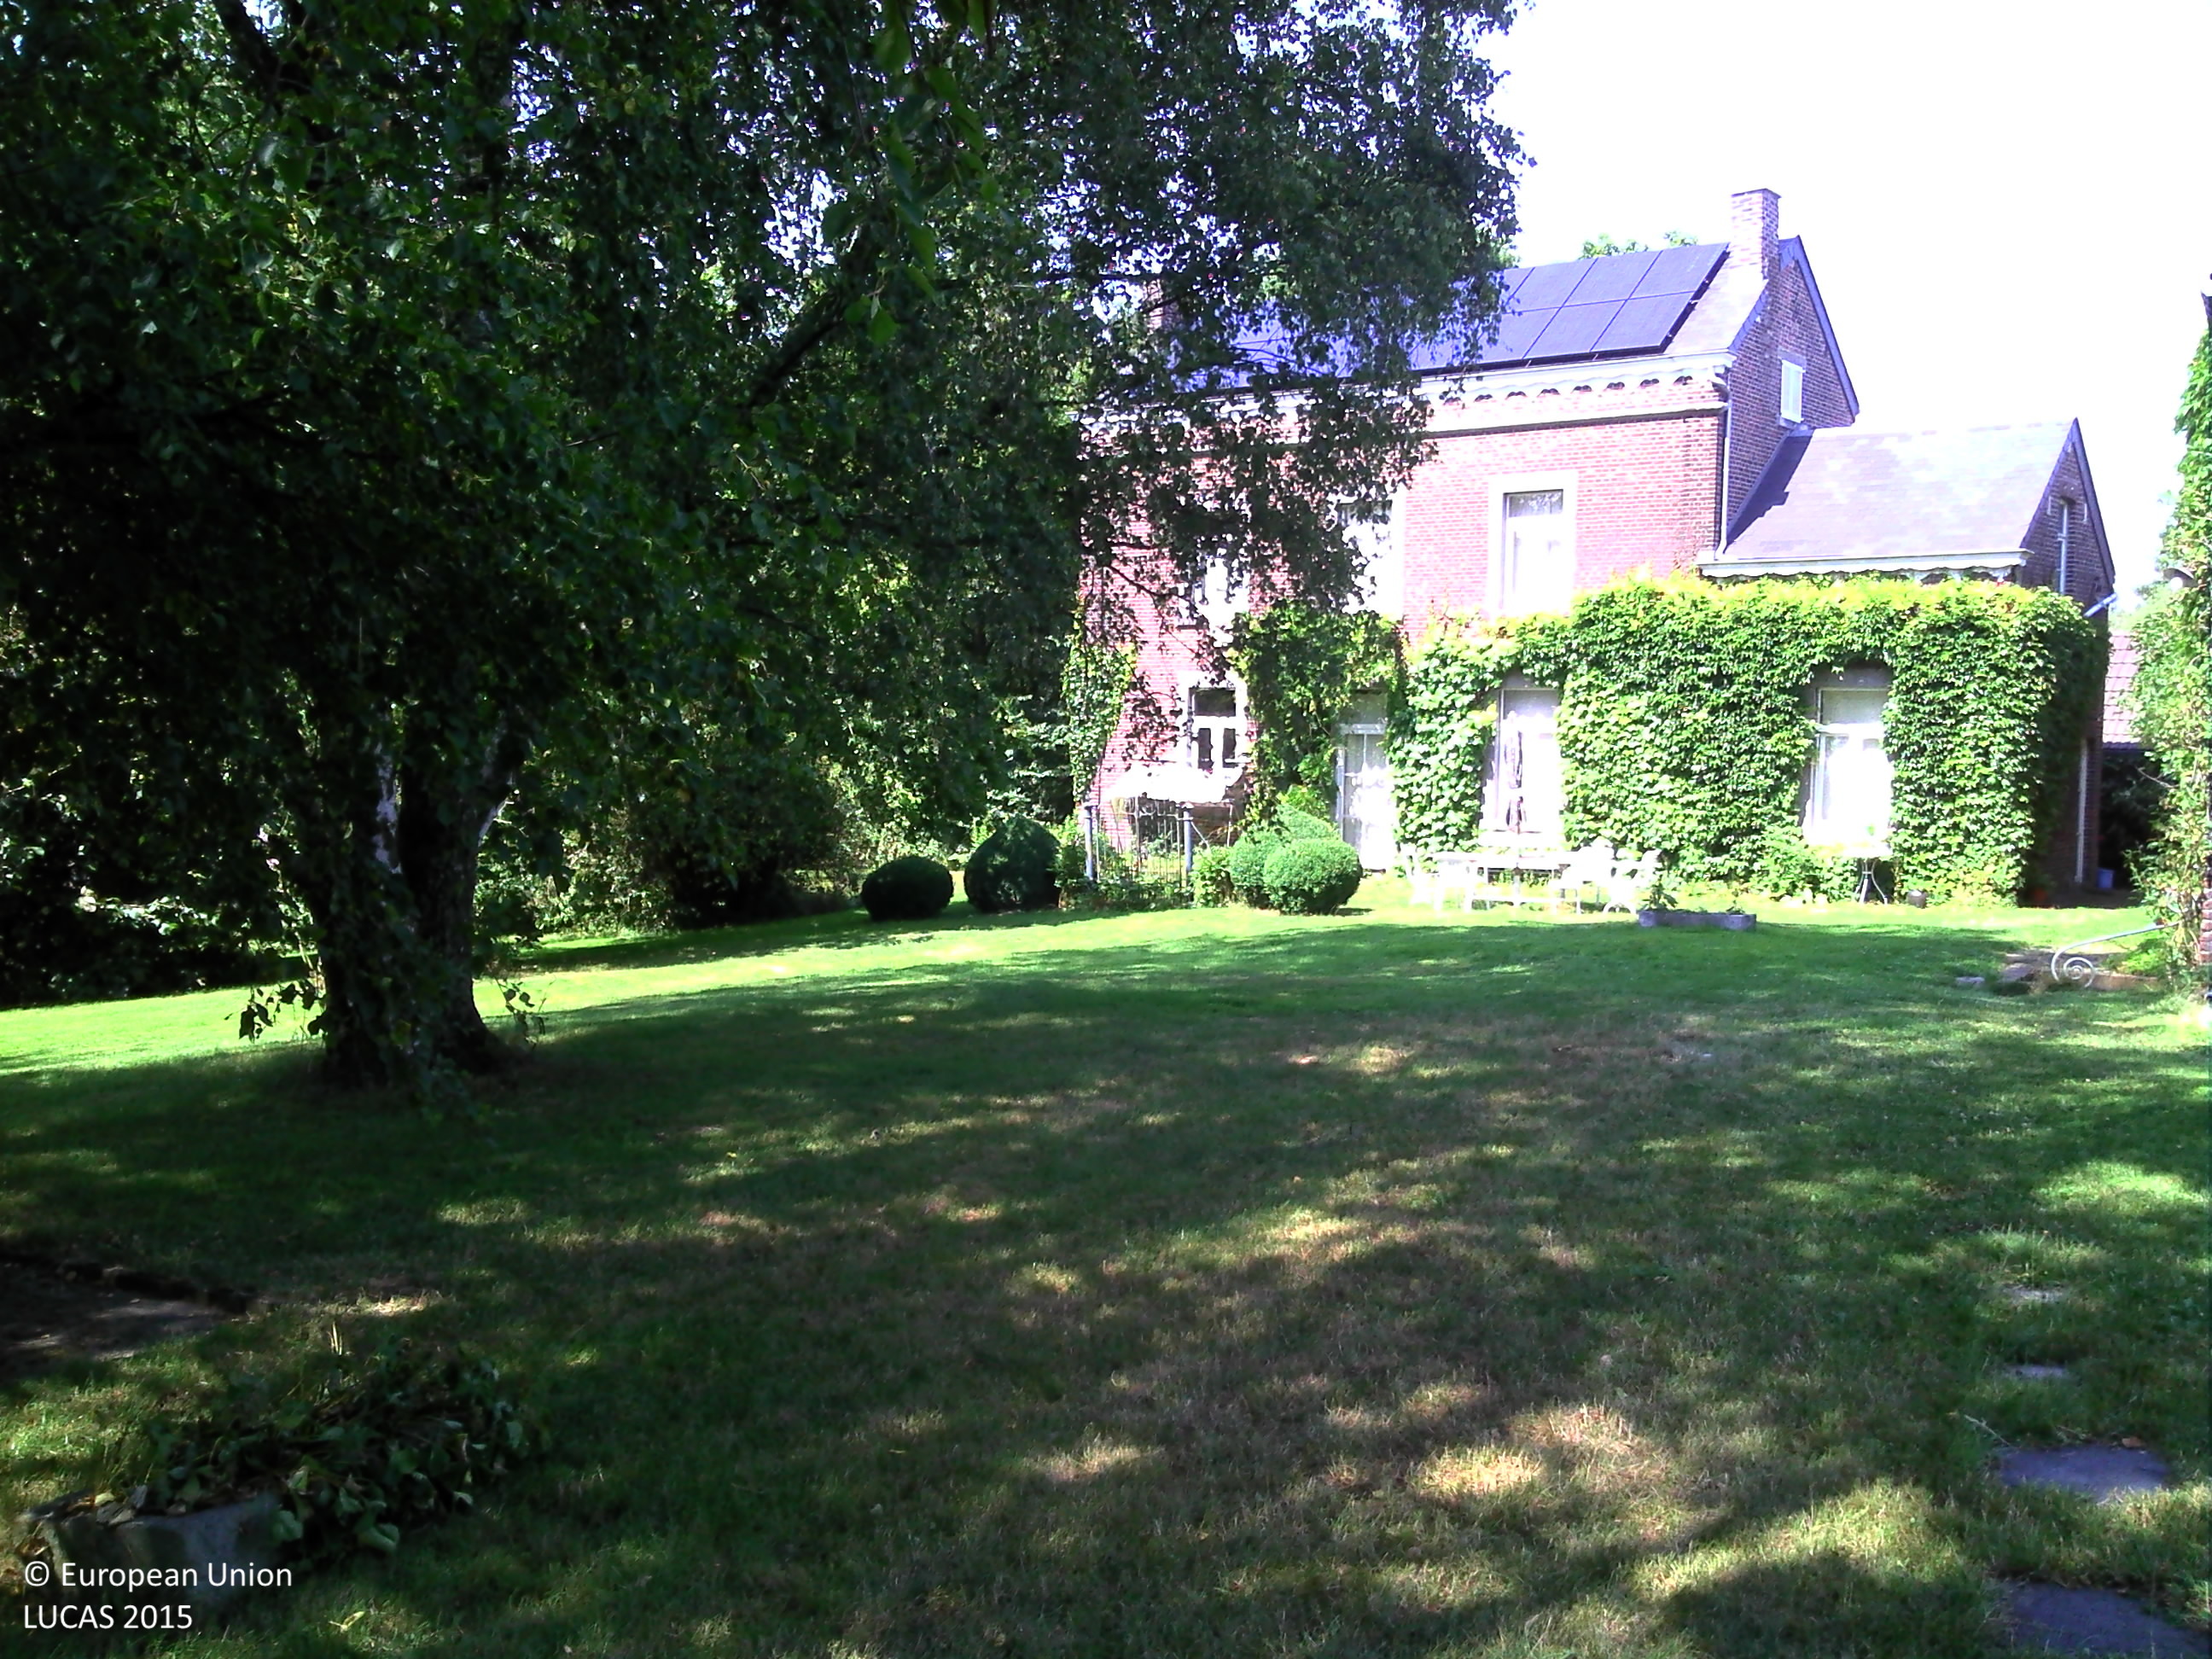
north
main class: Grassland
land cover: Grassland with sparse tree/shrub cover
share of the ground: > 75 %
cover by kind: herbaceous plants 95 %, broadleaved forest trees 5 %
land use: Residential
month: July
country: BE
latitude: 50.6428
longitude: 5.6855
